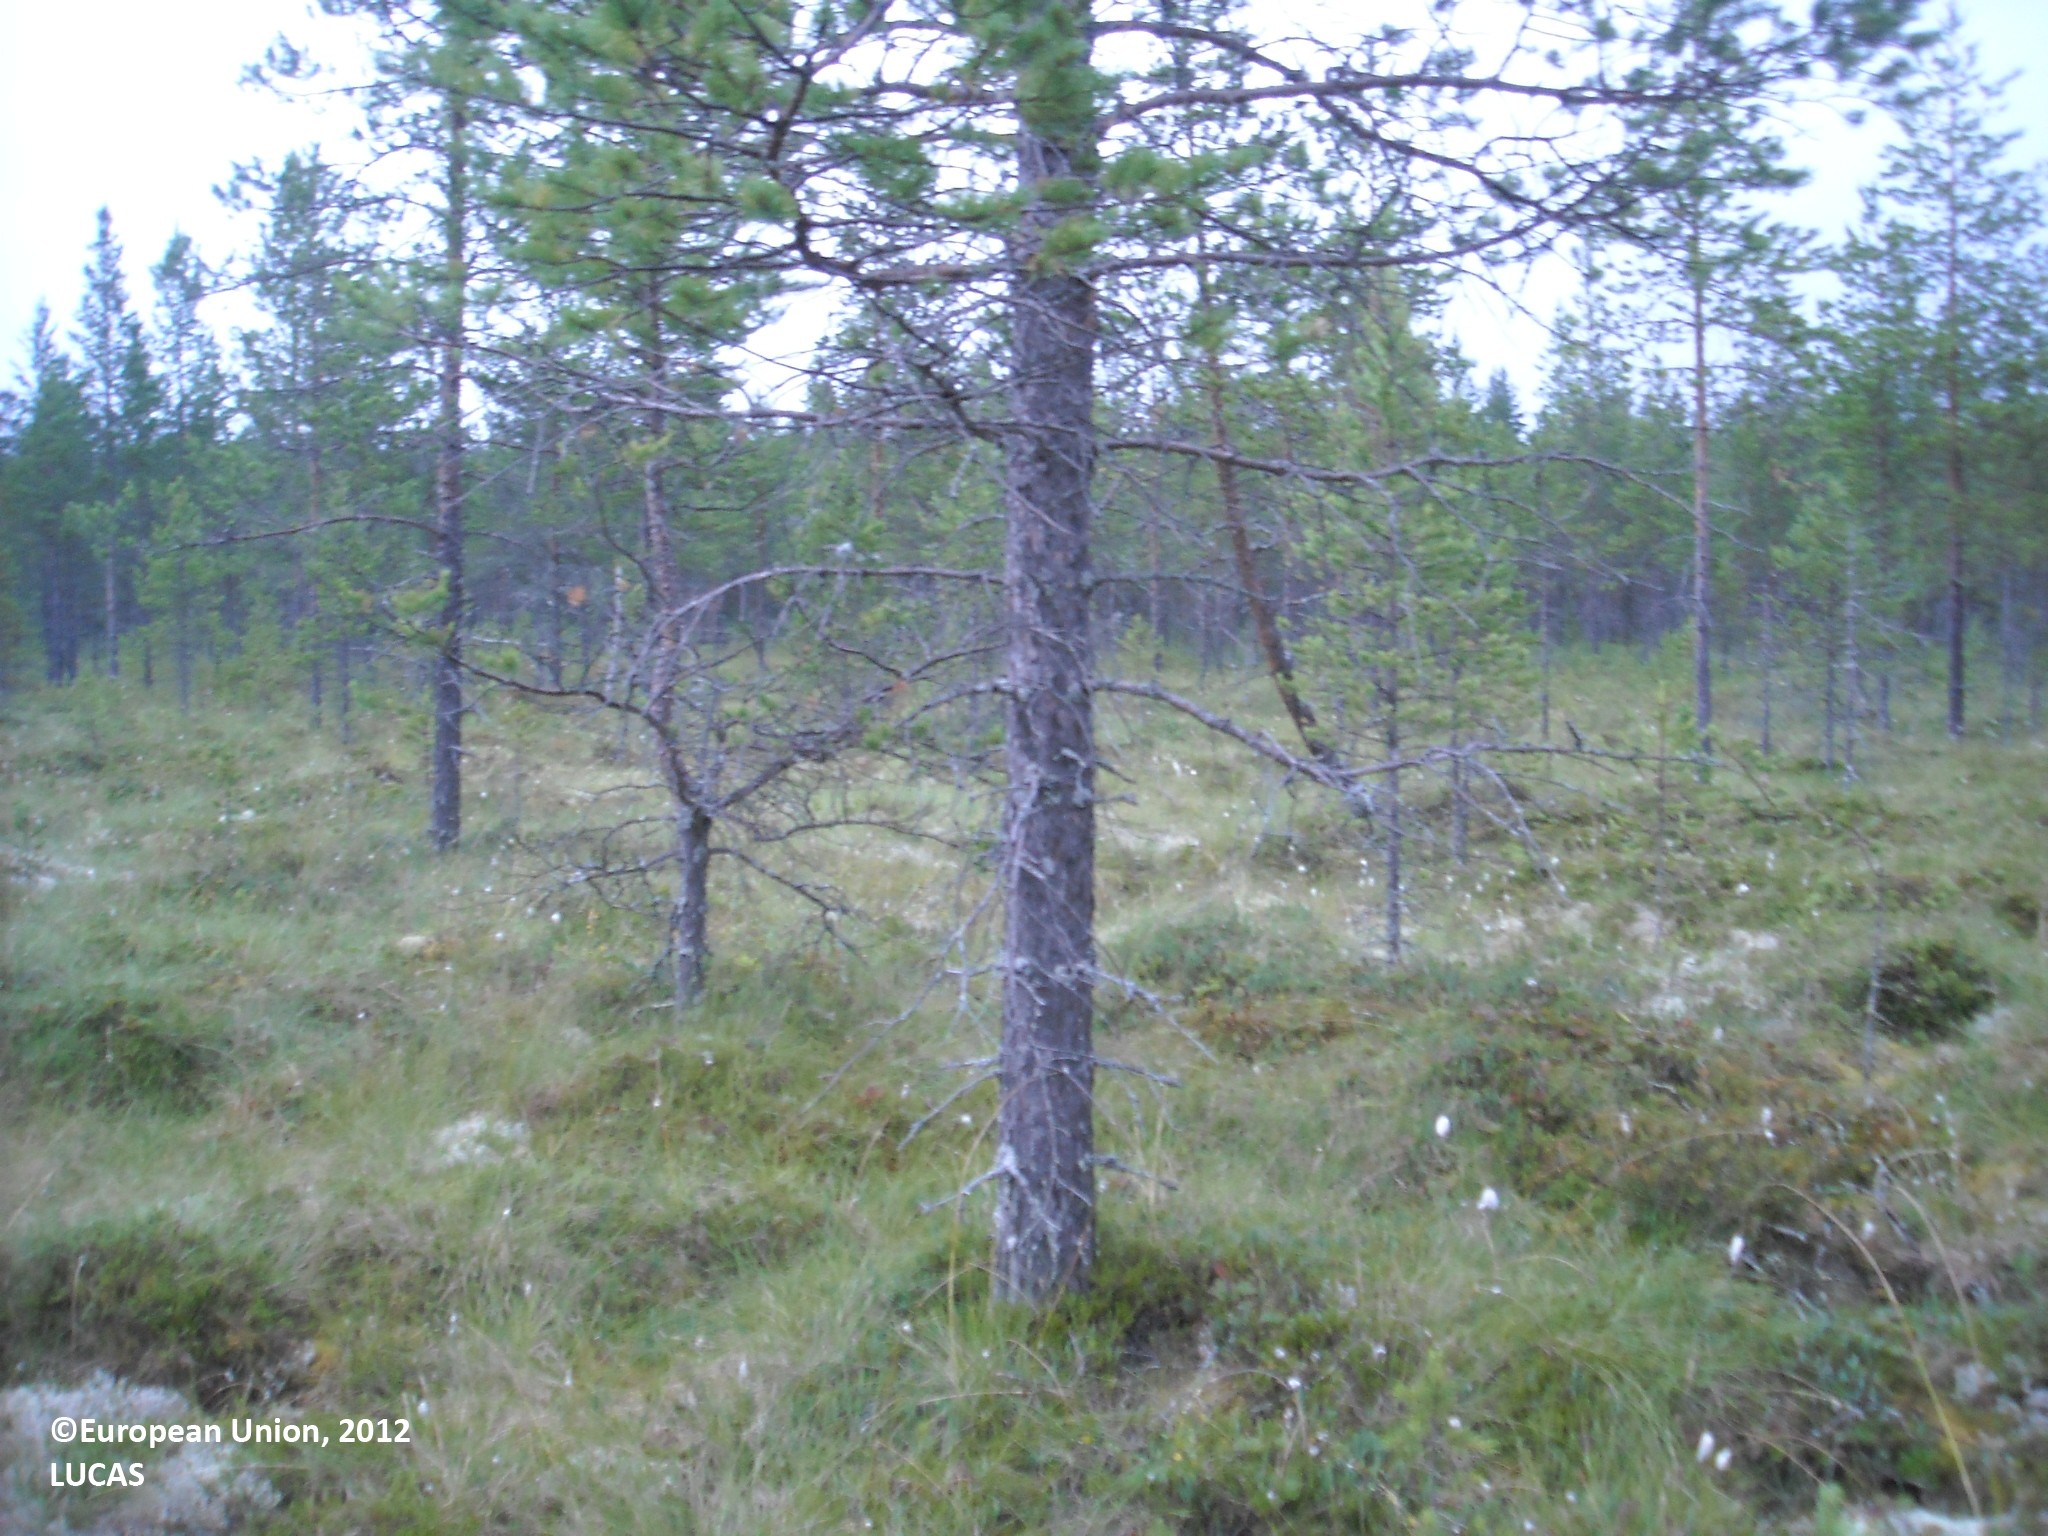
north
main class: Woodland
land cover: Pine dominated coniferous woodland
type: mire and swamp forests
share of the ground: 25 - 50 %
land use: Semi-natural and natural areas not in use
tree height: > 5 m
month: July
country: FI
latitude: 64.7958
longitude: 26.7654
